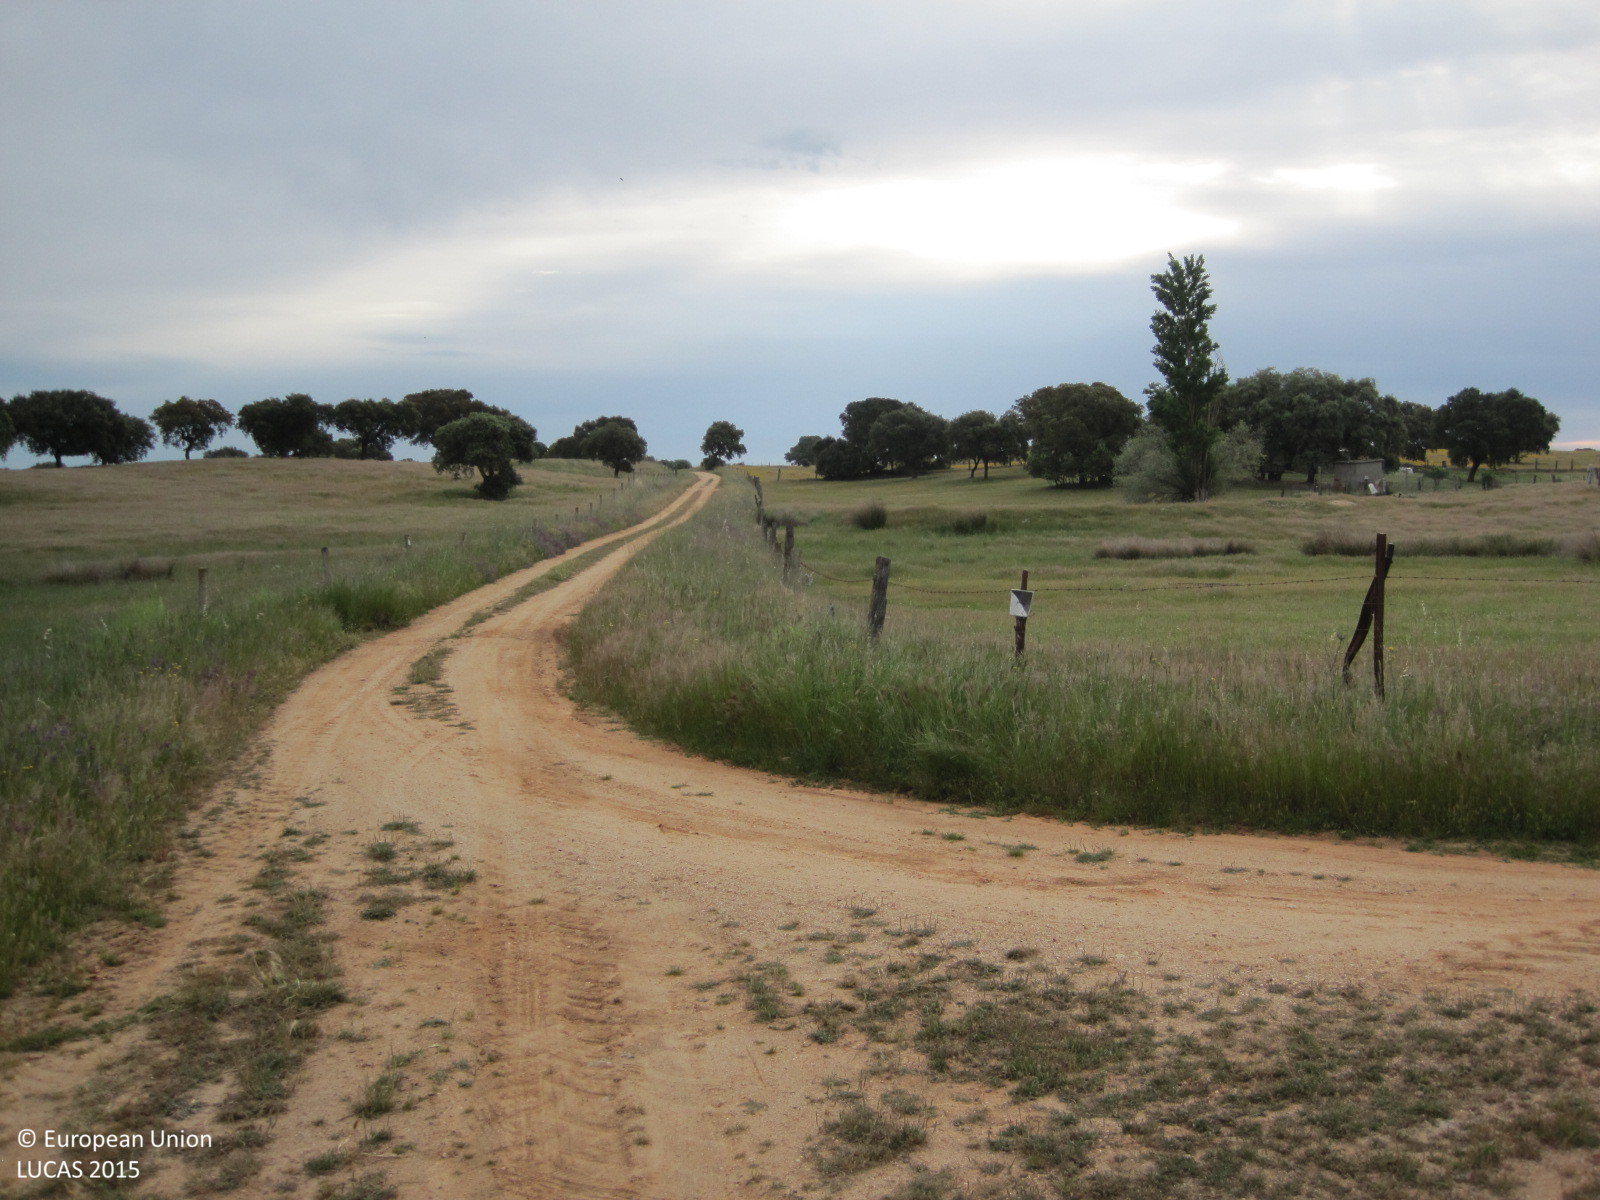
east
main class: Cropland
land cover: Arable land (only in case pi)
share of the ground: > 75 %
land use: Agriculture (excluding fallow land and kitchen gardens)
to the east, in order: Arable land (only in case pi); Groves; Grassland with sparse tree/shrub cover; Tracks; Grassland with sparse tree/shrub cover
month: May
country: ES
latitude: 39.8951
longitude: -5.1270
